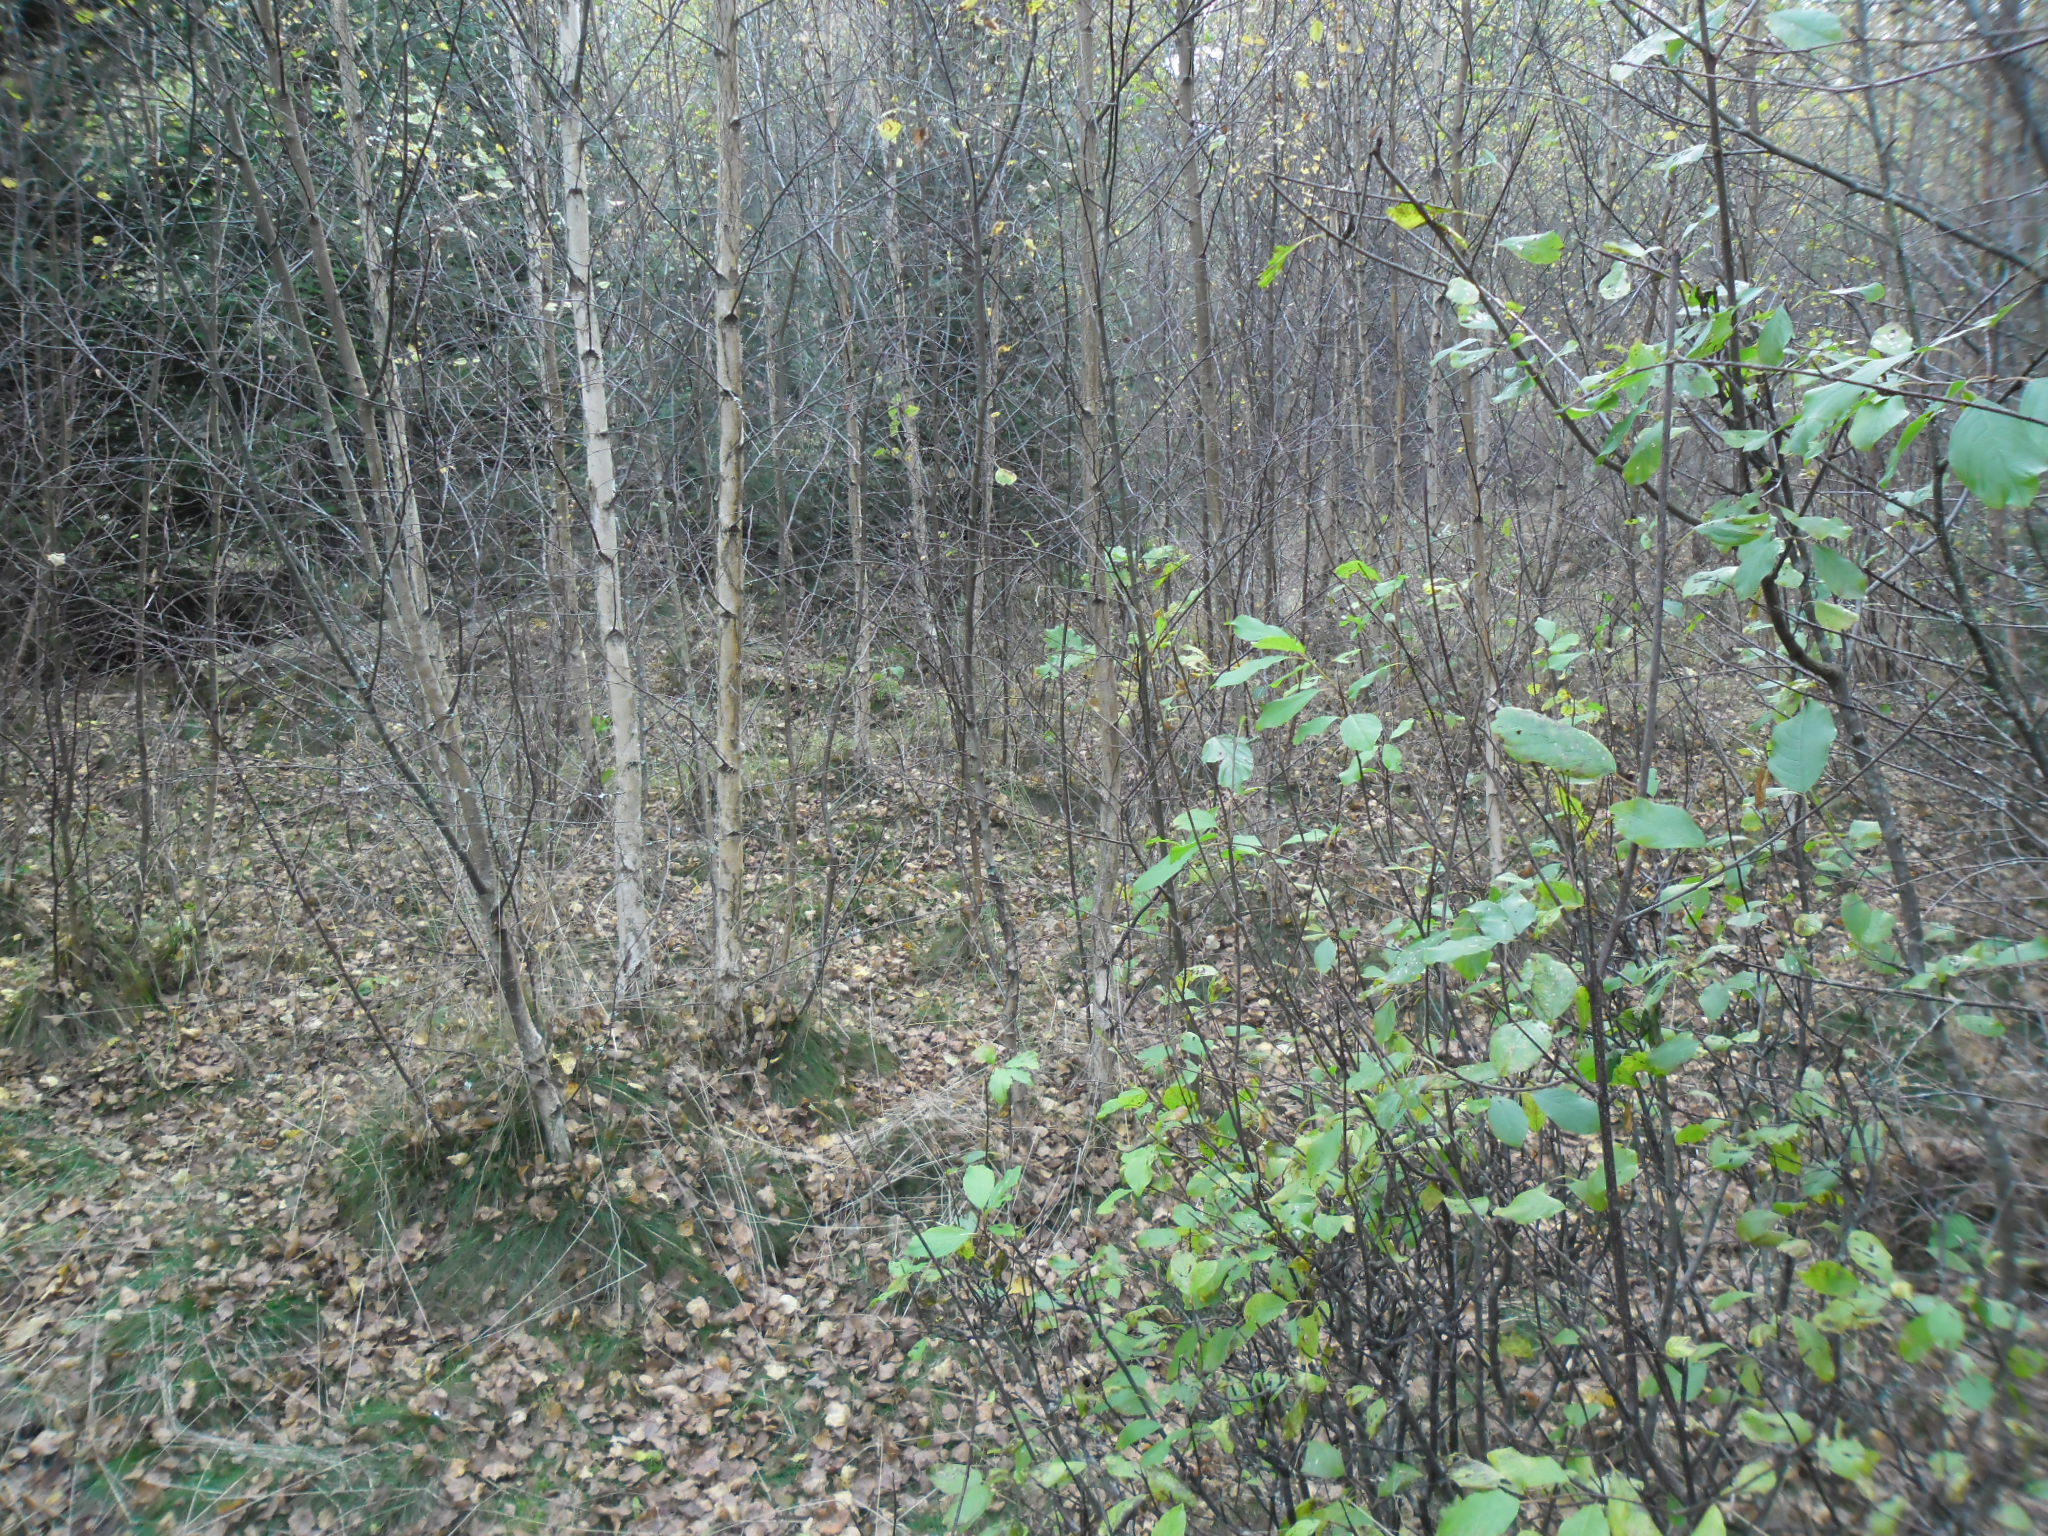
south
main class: Woodland
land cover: Spruce dominated mixed woodland
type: boreal forest
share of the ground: > 75 %
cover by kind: coniferous forest trees 60 %, broadleaved forest trees 30 %, herbaceous plants 10 %
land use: Forestry
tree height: < 5 m
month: October
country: SE
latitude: 56.2947
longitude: 13.7621
